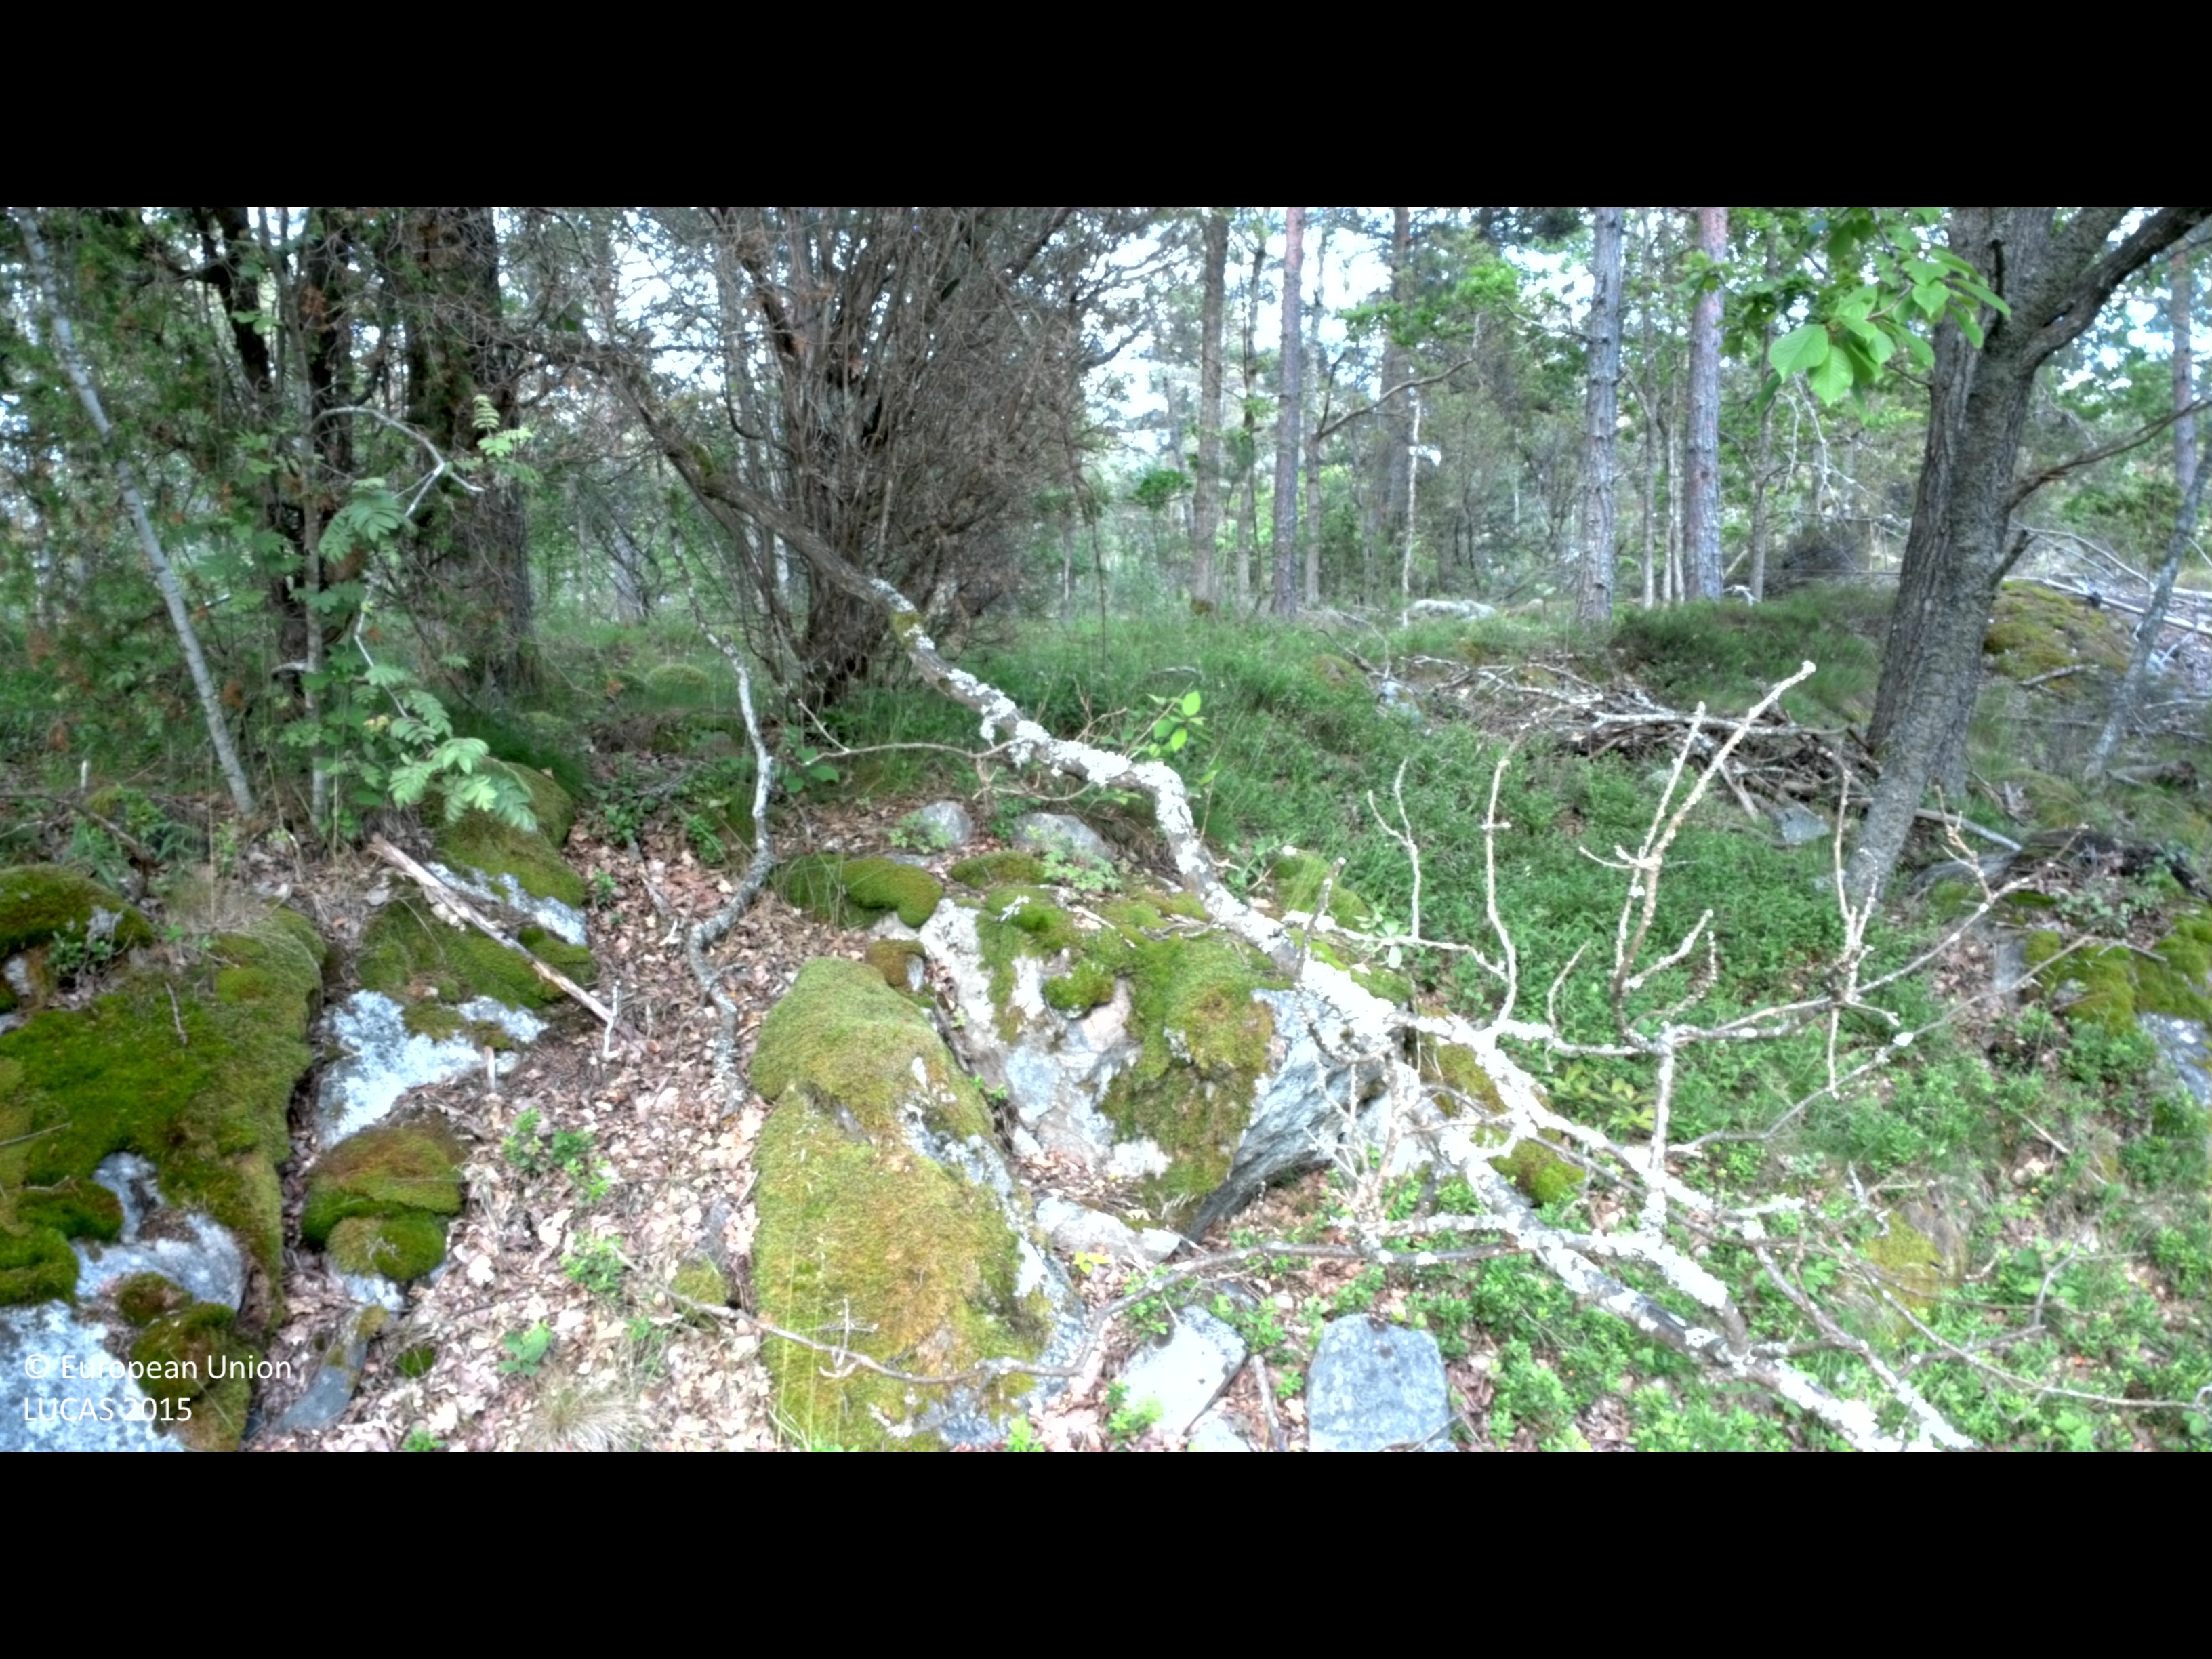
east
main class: Grassland
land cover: Grassland without tree/shrub cover
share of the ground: > 75 %
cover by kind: herbaceous plants 90 %, lichens and mosses 10 %
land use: Agriculture (excluding fallow land and kitchen gardens)
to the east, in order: Grassland without tree/shrub cover; Ditches and canals; Pine dominated mixed woodland; Pine dominated coniferous woodland; Pine dominated mixed woodland; Ditches and canals; Other bare soil; Pine dominated mixed woodland
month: June
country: SE
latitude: 57.9975
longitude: 16.7148
